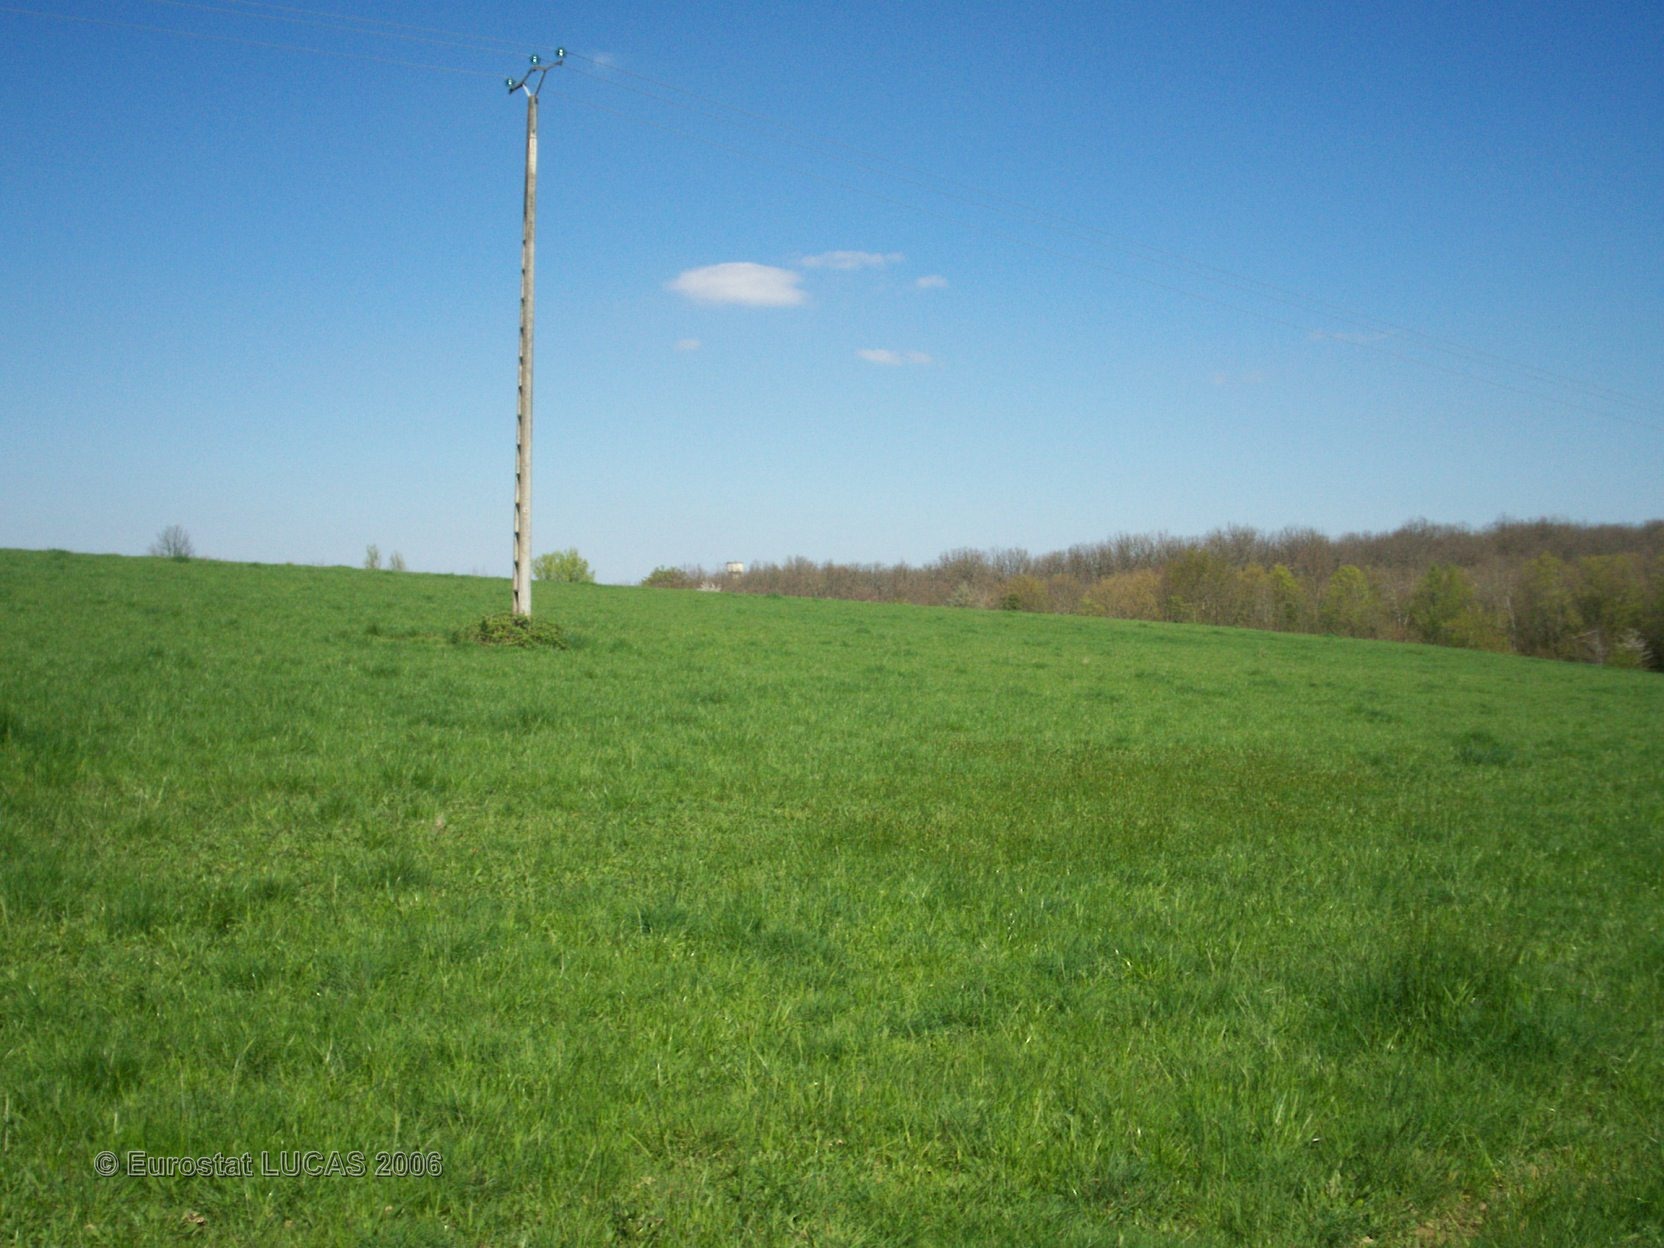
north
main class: Grassland
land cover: Grassland without tree/shrub cover
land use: Agriculture (excluding fallow land and kitchen gardens)
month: April
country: FR
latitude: 44.0228
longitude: 0.9027
